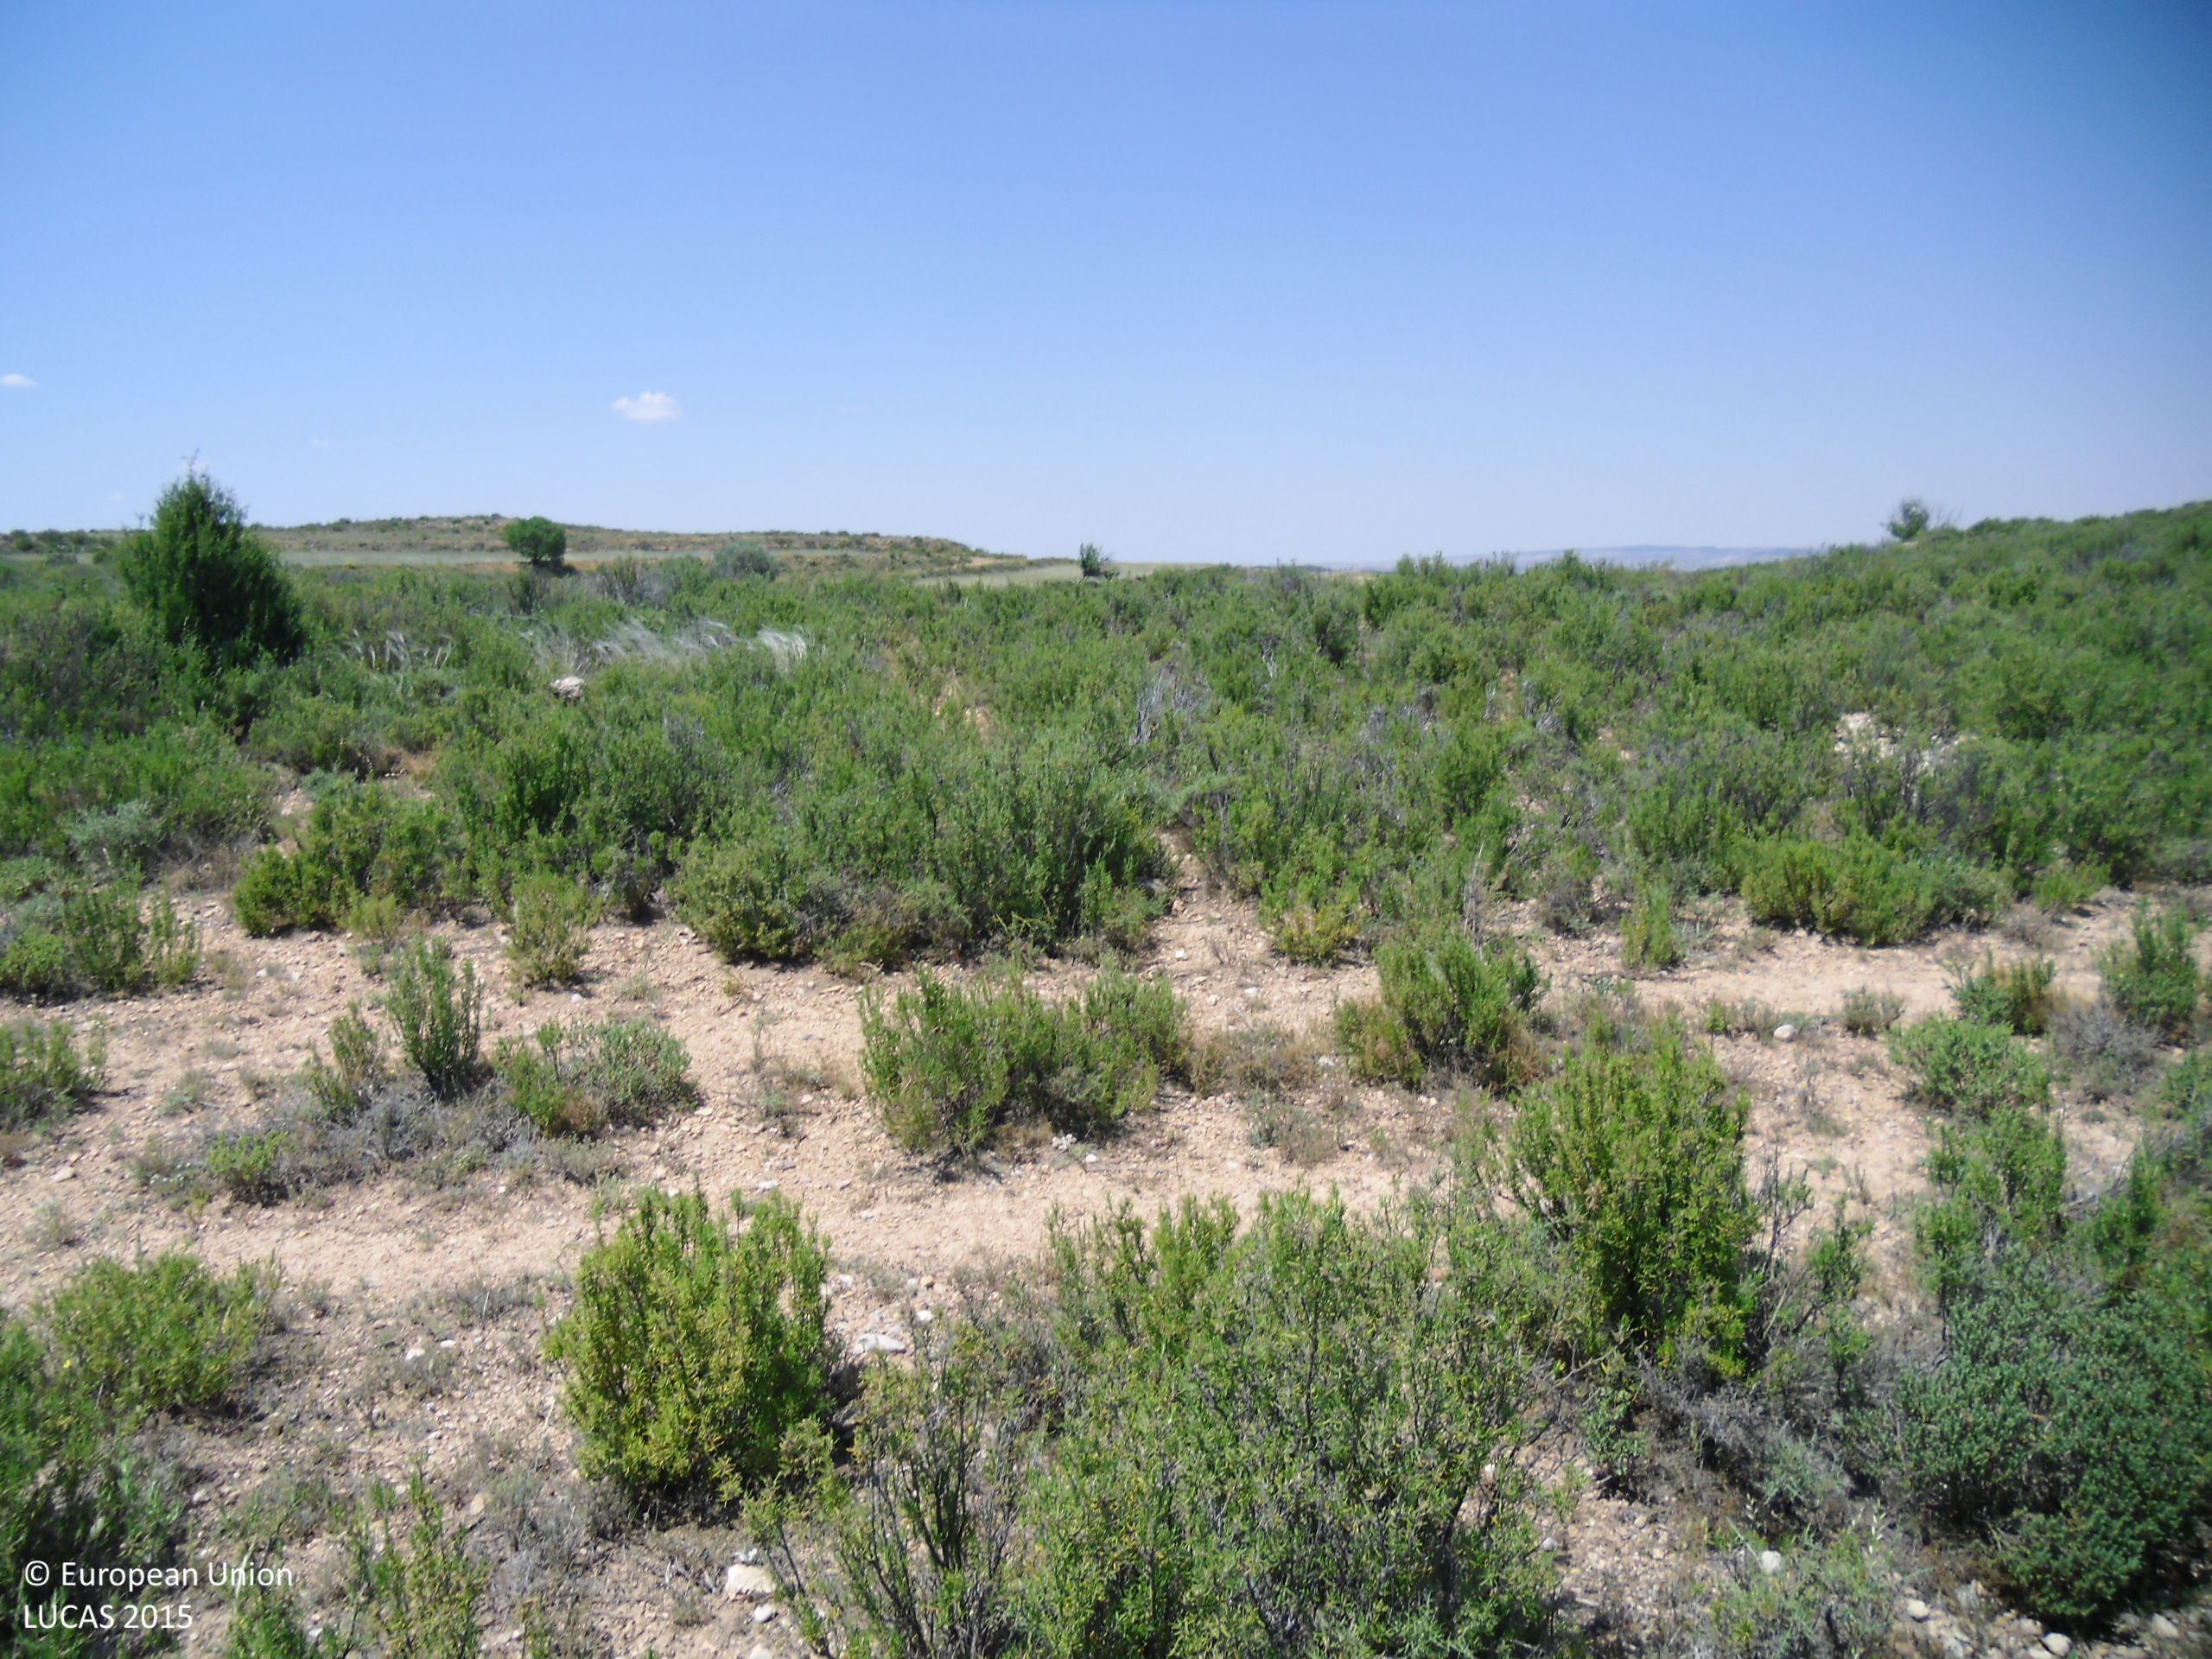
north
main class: Shrubland
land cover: Shrubland without tree cover
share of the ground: 25 - 50 %
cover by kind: shrubs 40 %, herbaceous plants 20 %, consolidated bare surface 20 %, unconsolidated bare surface 20 %
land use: Semi-natural and natural areas not in use
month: June
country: ES
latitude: 40.9059
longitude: -0.6621
